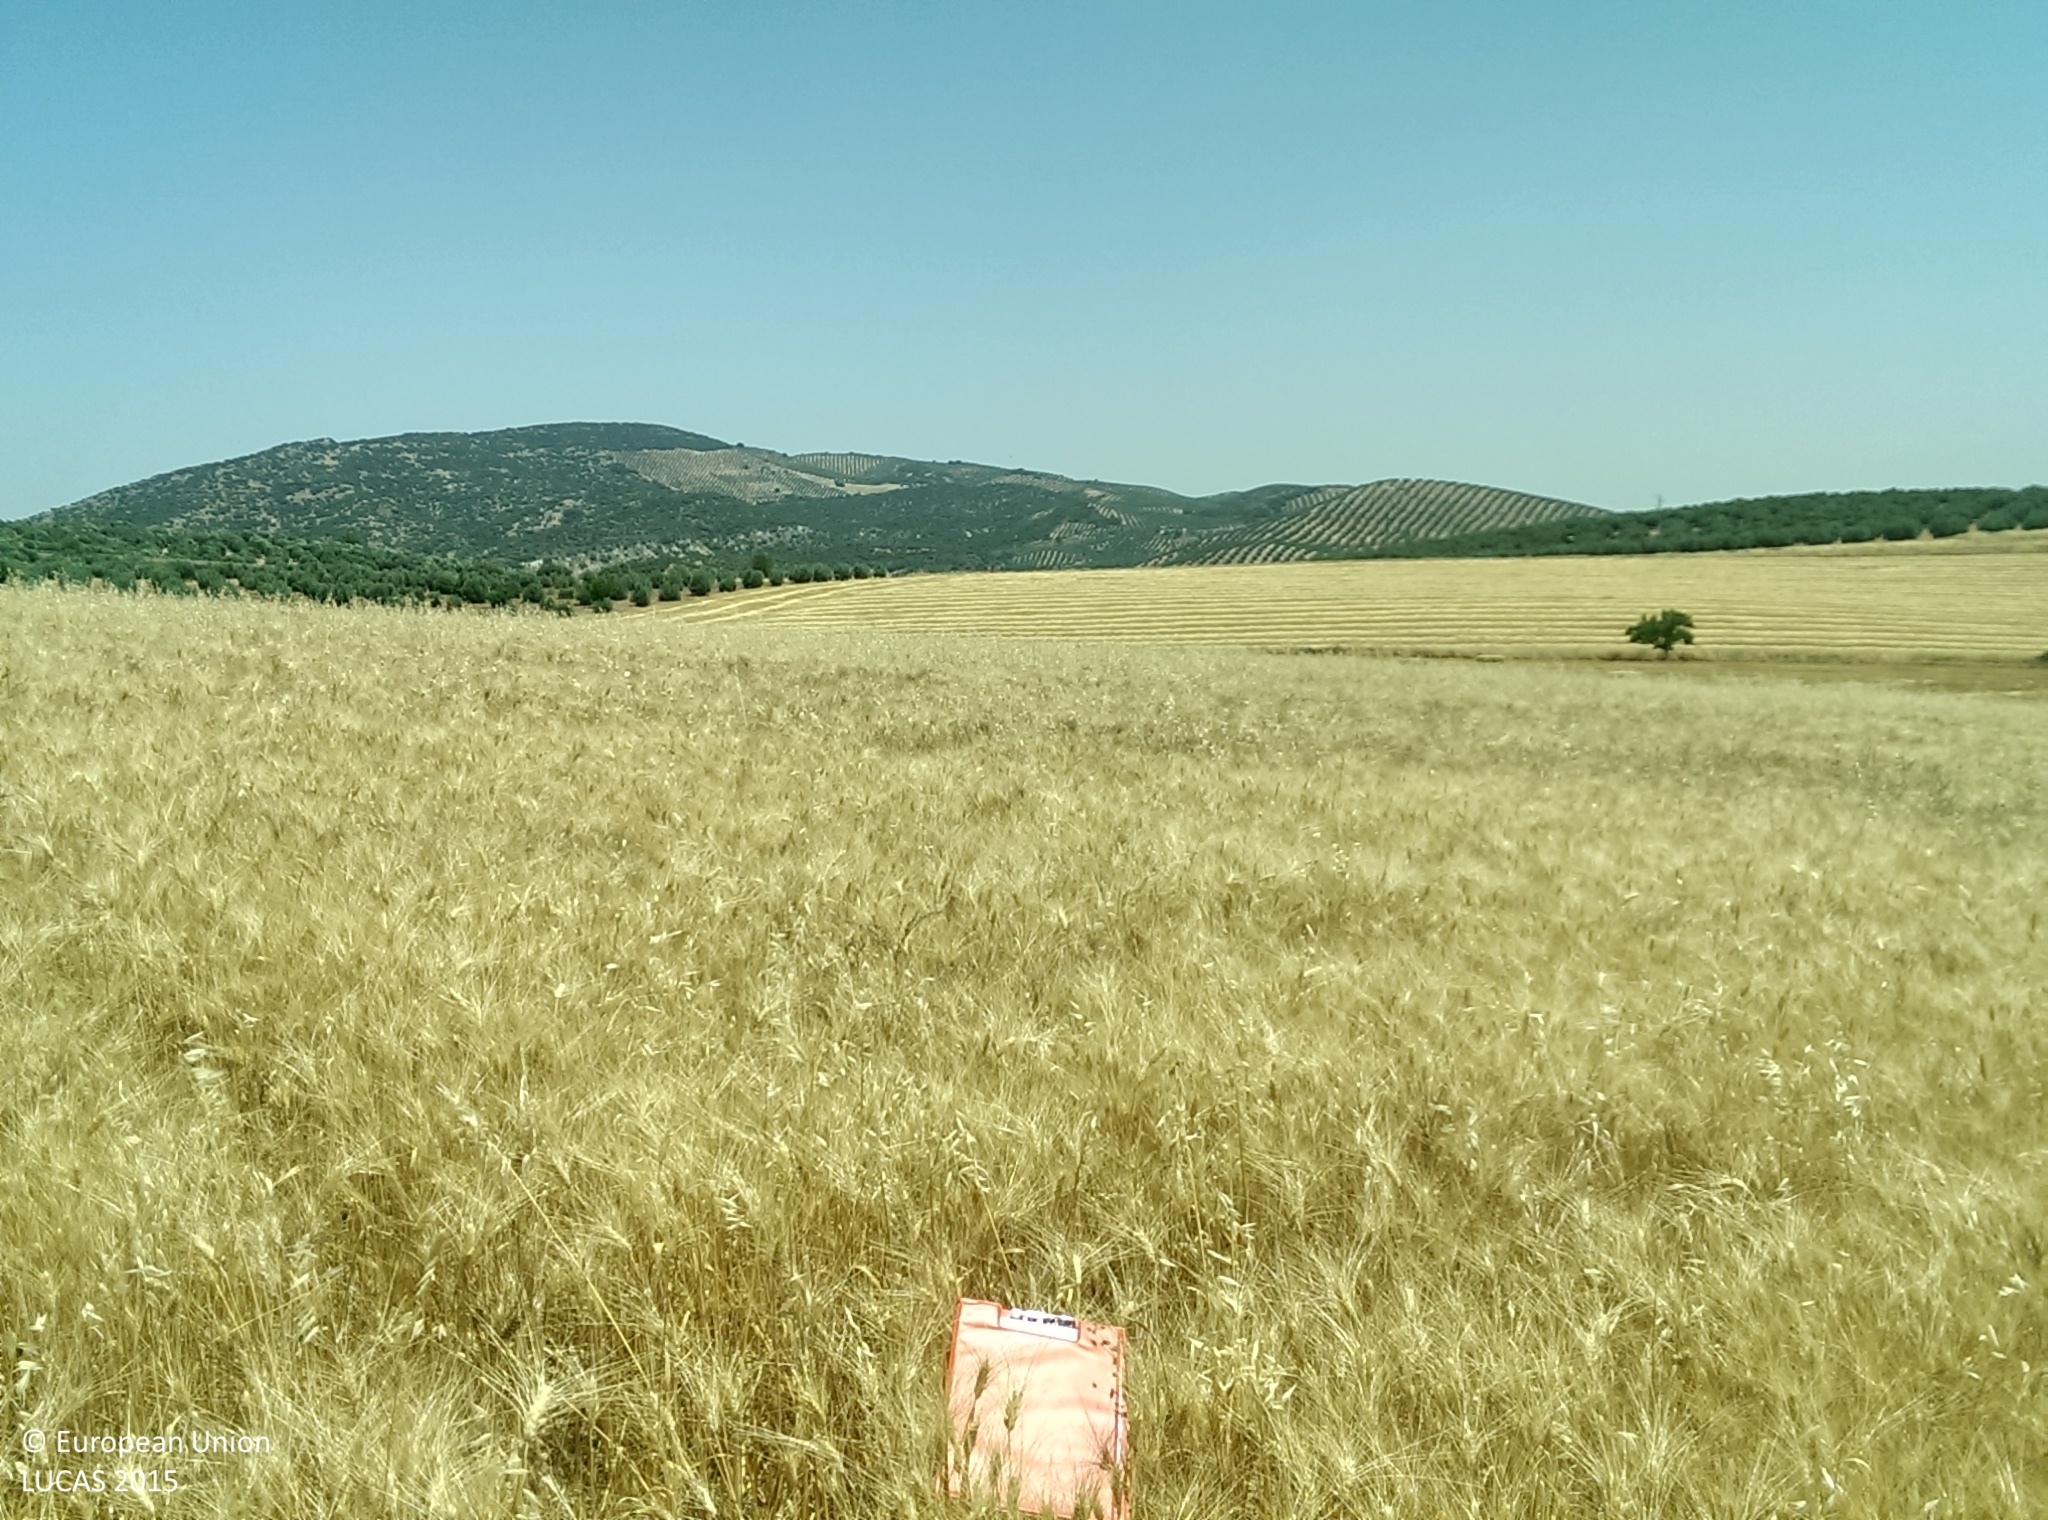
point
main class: Cropland
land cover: Common wheat
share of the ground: > 75 %
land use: Agriculture (excluding fallow land and kitchen gardens)
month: July
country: ES
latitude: 37.4235
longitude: -3.7468
